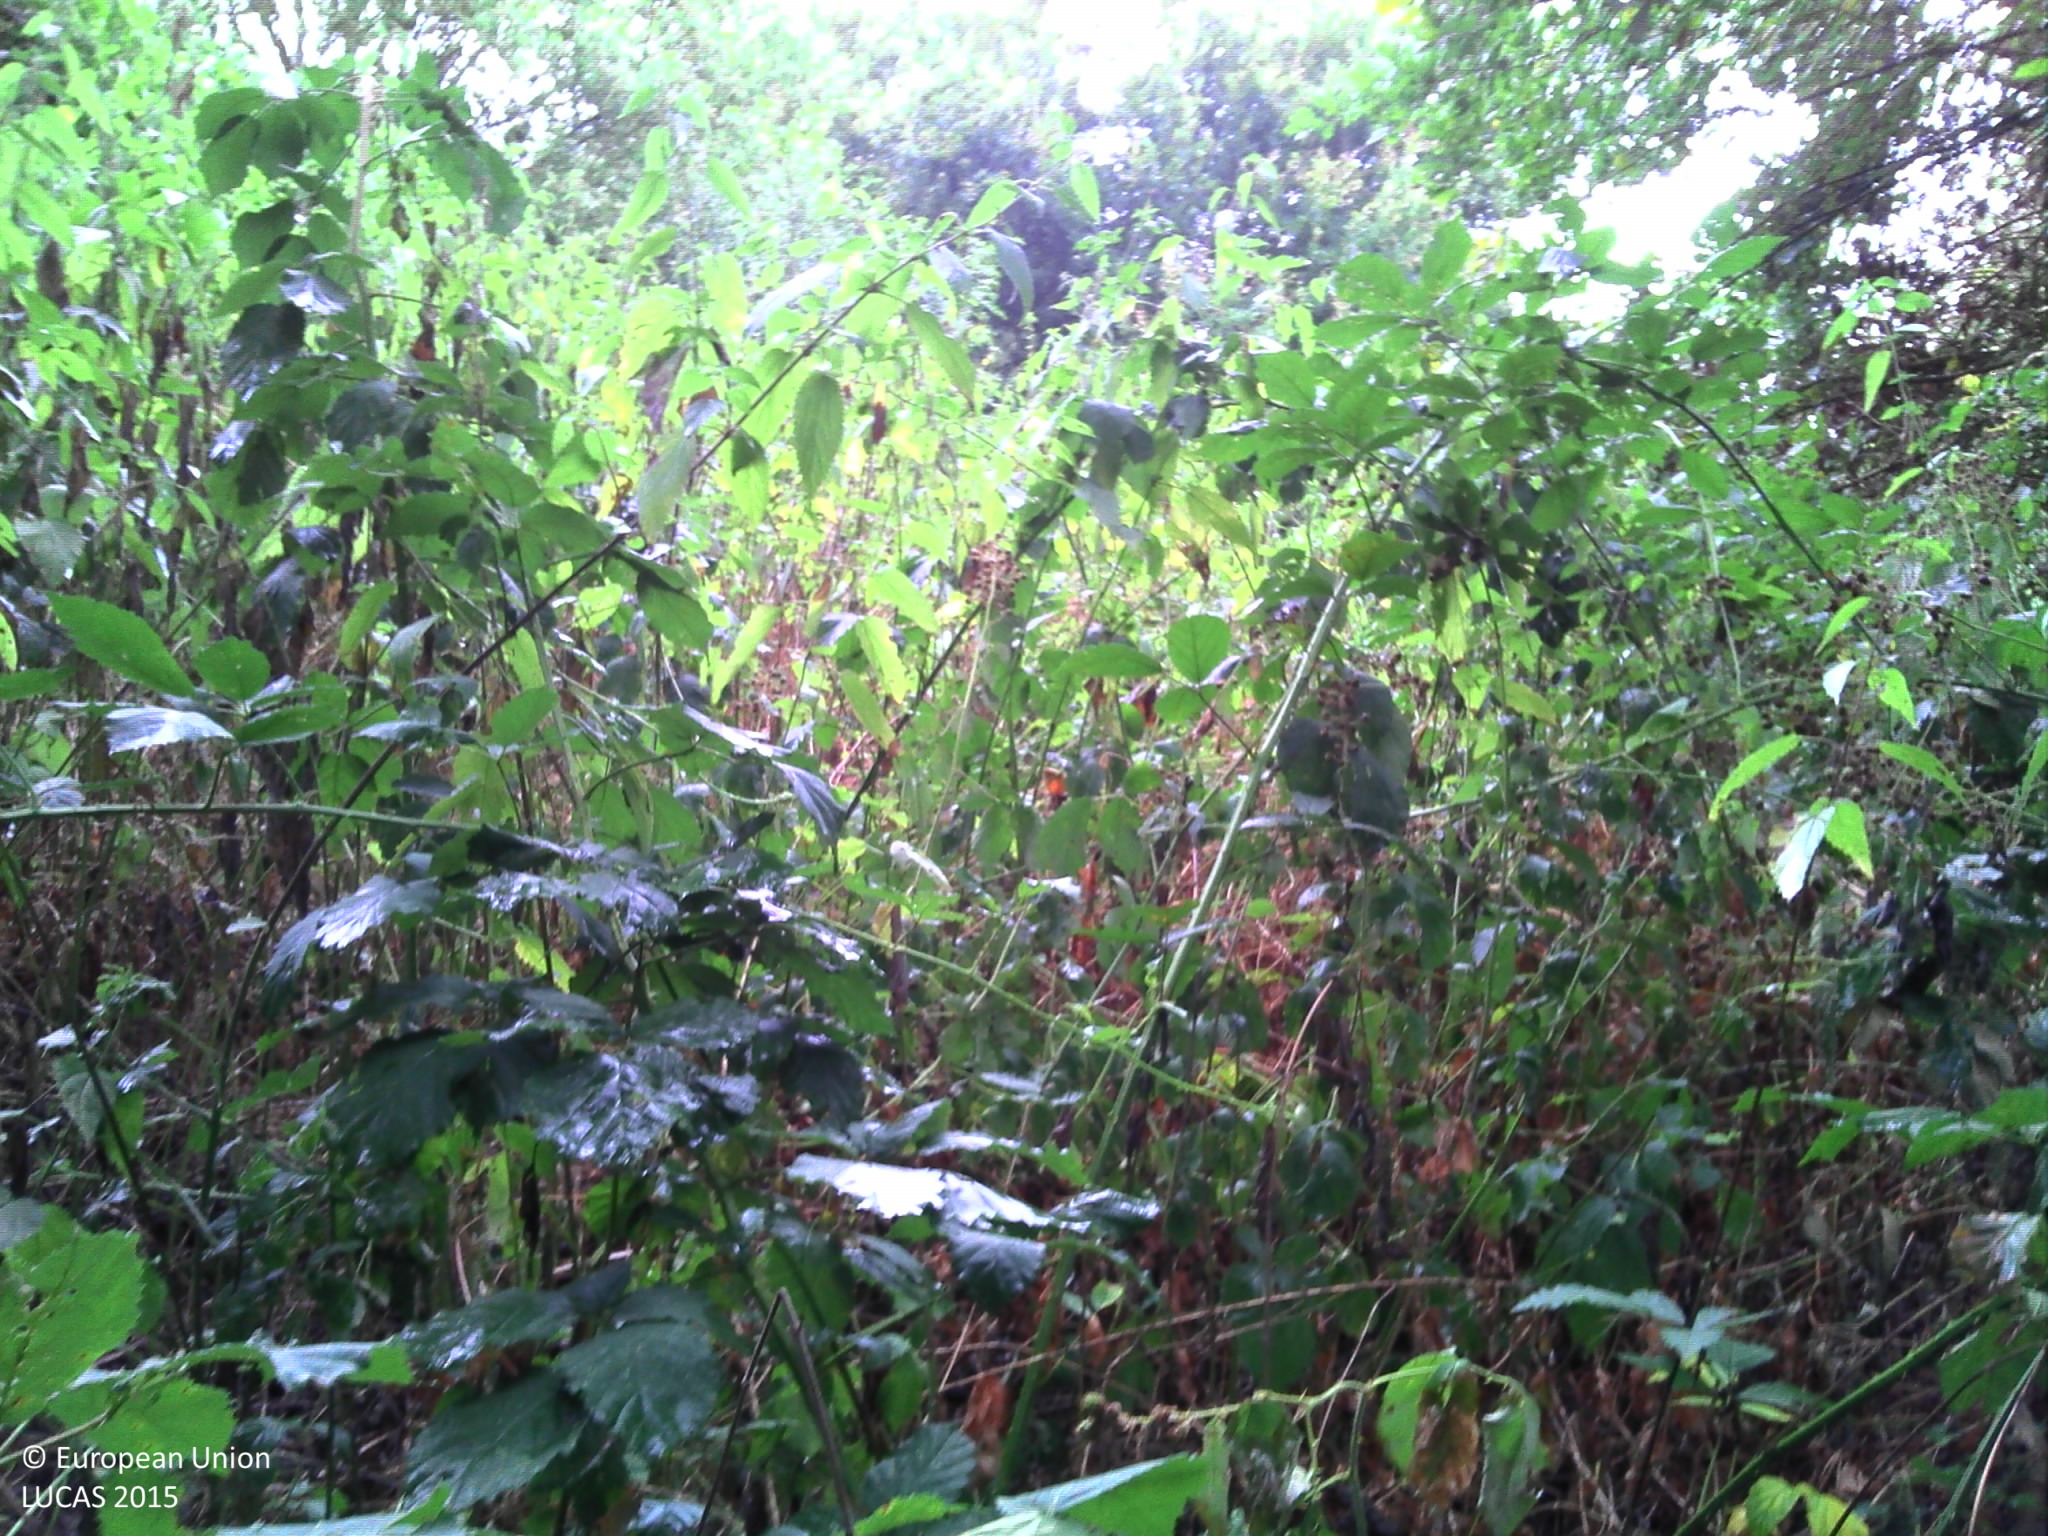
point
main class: Woodland
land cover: Broadleaved woodland
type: mesophytic deciduous forest
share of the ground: > 75 %
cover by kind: broadleaved forest trees 80 %, herbaceous plants 15 %, lichens and mosses 5 %
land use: Semi-natural and natural areas not in use
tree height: > 5 m
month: August
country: FR
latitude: 47.6451
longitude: 3.0854
